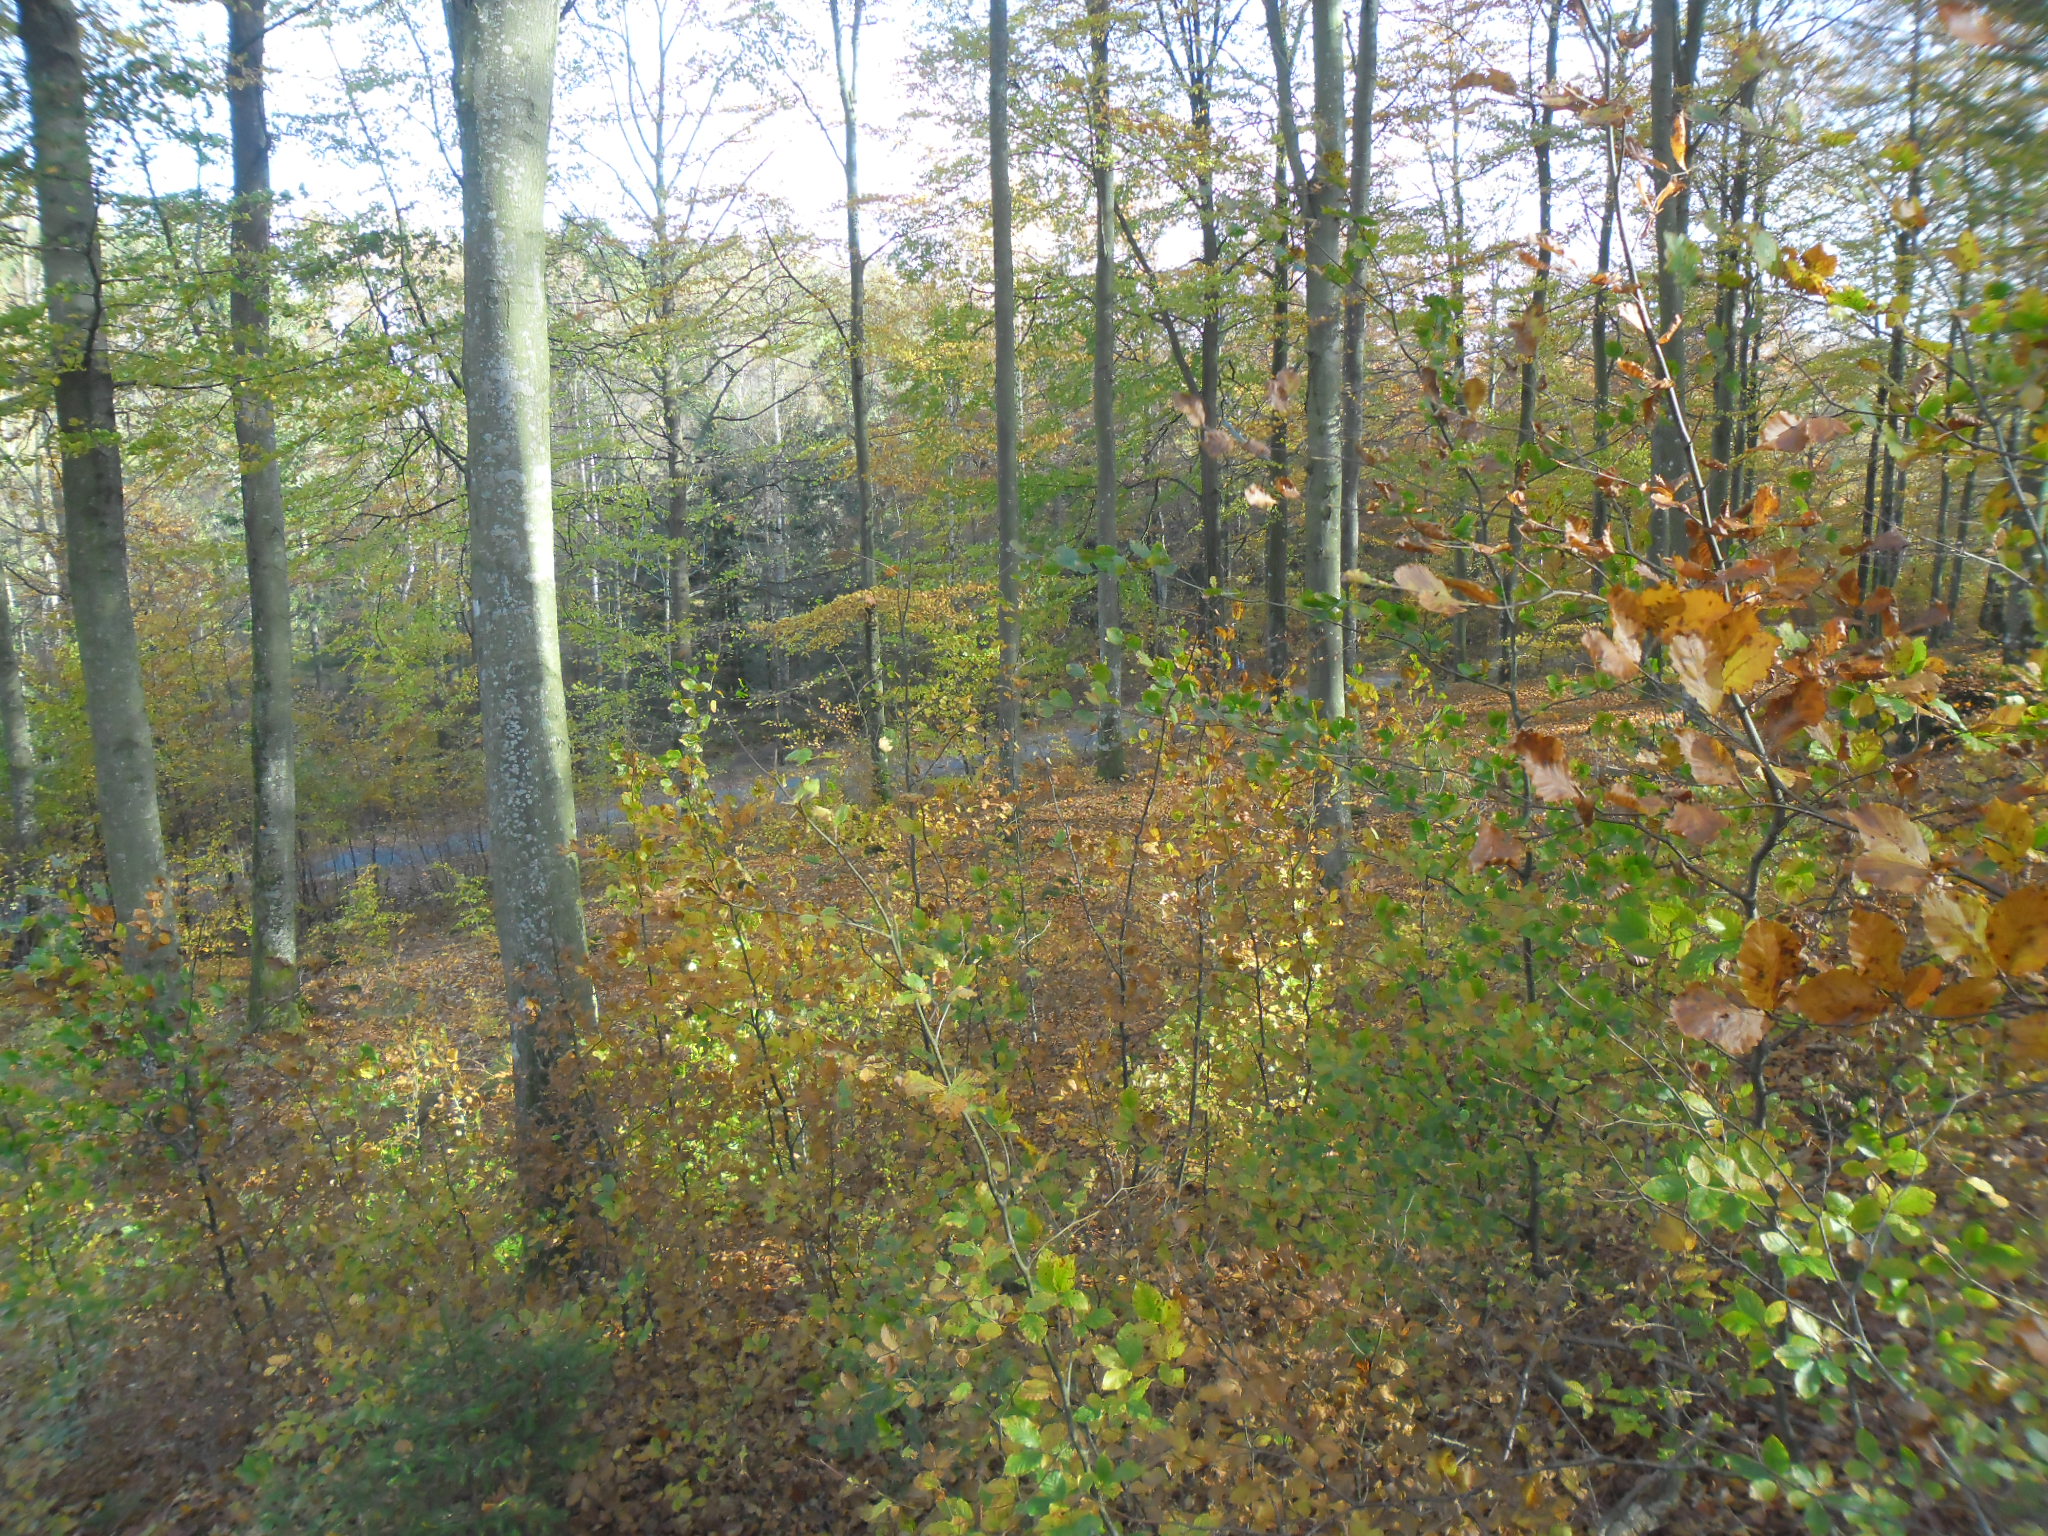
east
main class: Woodland
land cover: Broadleaved woodland
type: beech forest
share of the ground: > 75 %
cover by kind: broadleaved forest trees 80 %, herbaceous plants 20 %
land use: Forestry
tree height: > 5 m
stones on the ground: > 50 %
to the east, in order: Broadleaved woodland; Grass margins; Paved roads, cycling and walking lanes; Grass margins; Broadleaved woodland; Spruce dominated coniferous woodland; Spruce dominated mixed woodland
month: October
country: SE
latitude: 56.3665
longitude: 13.0892
